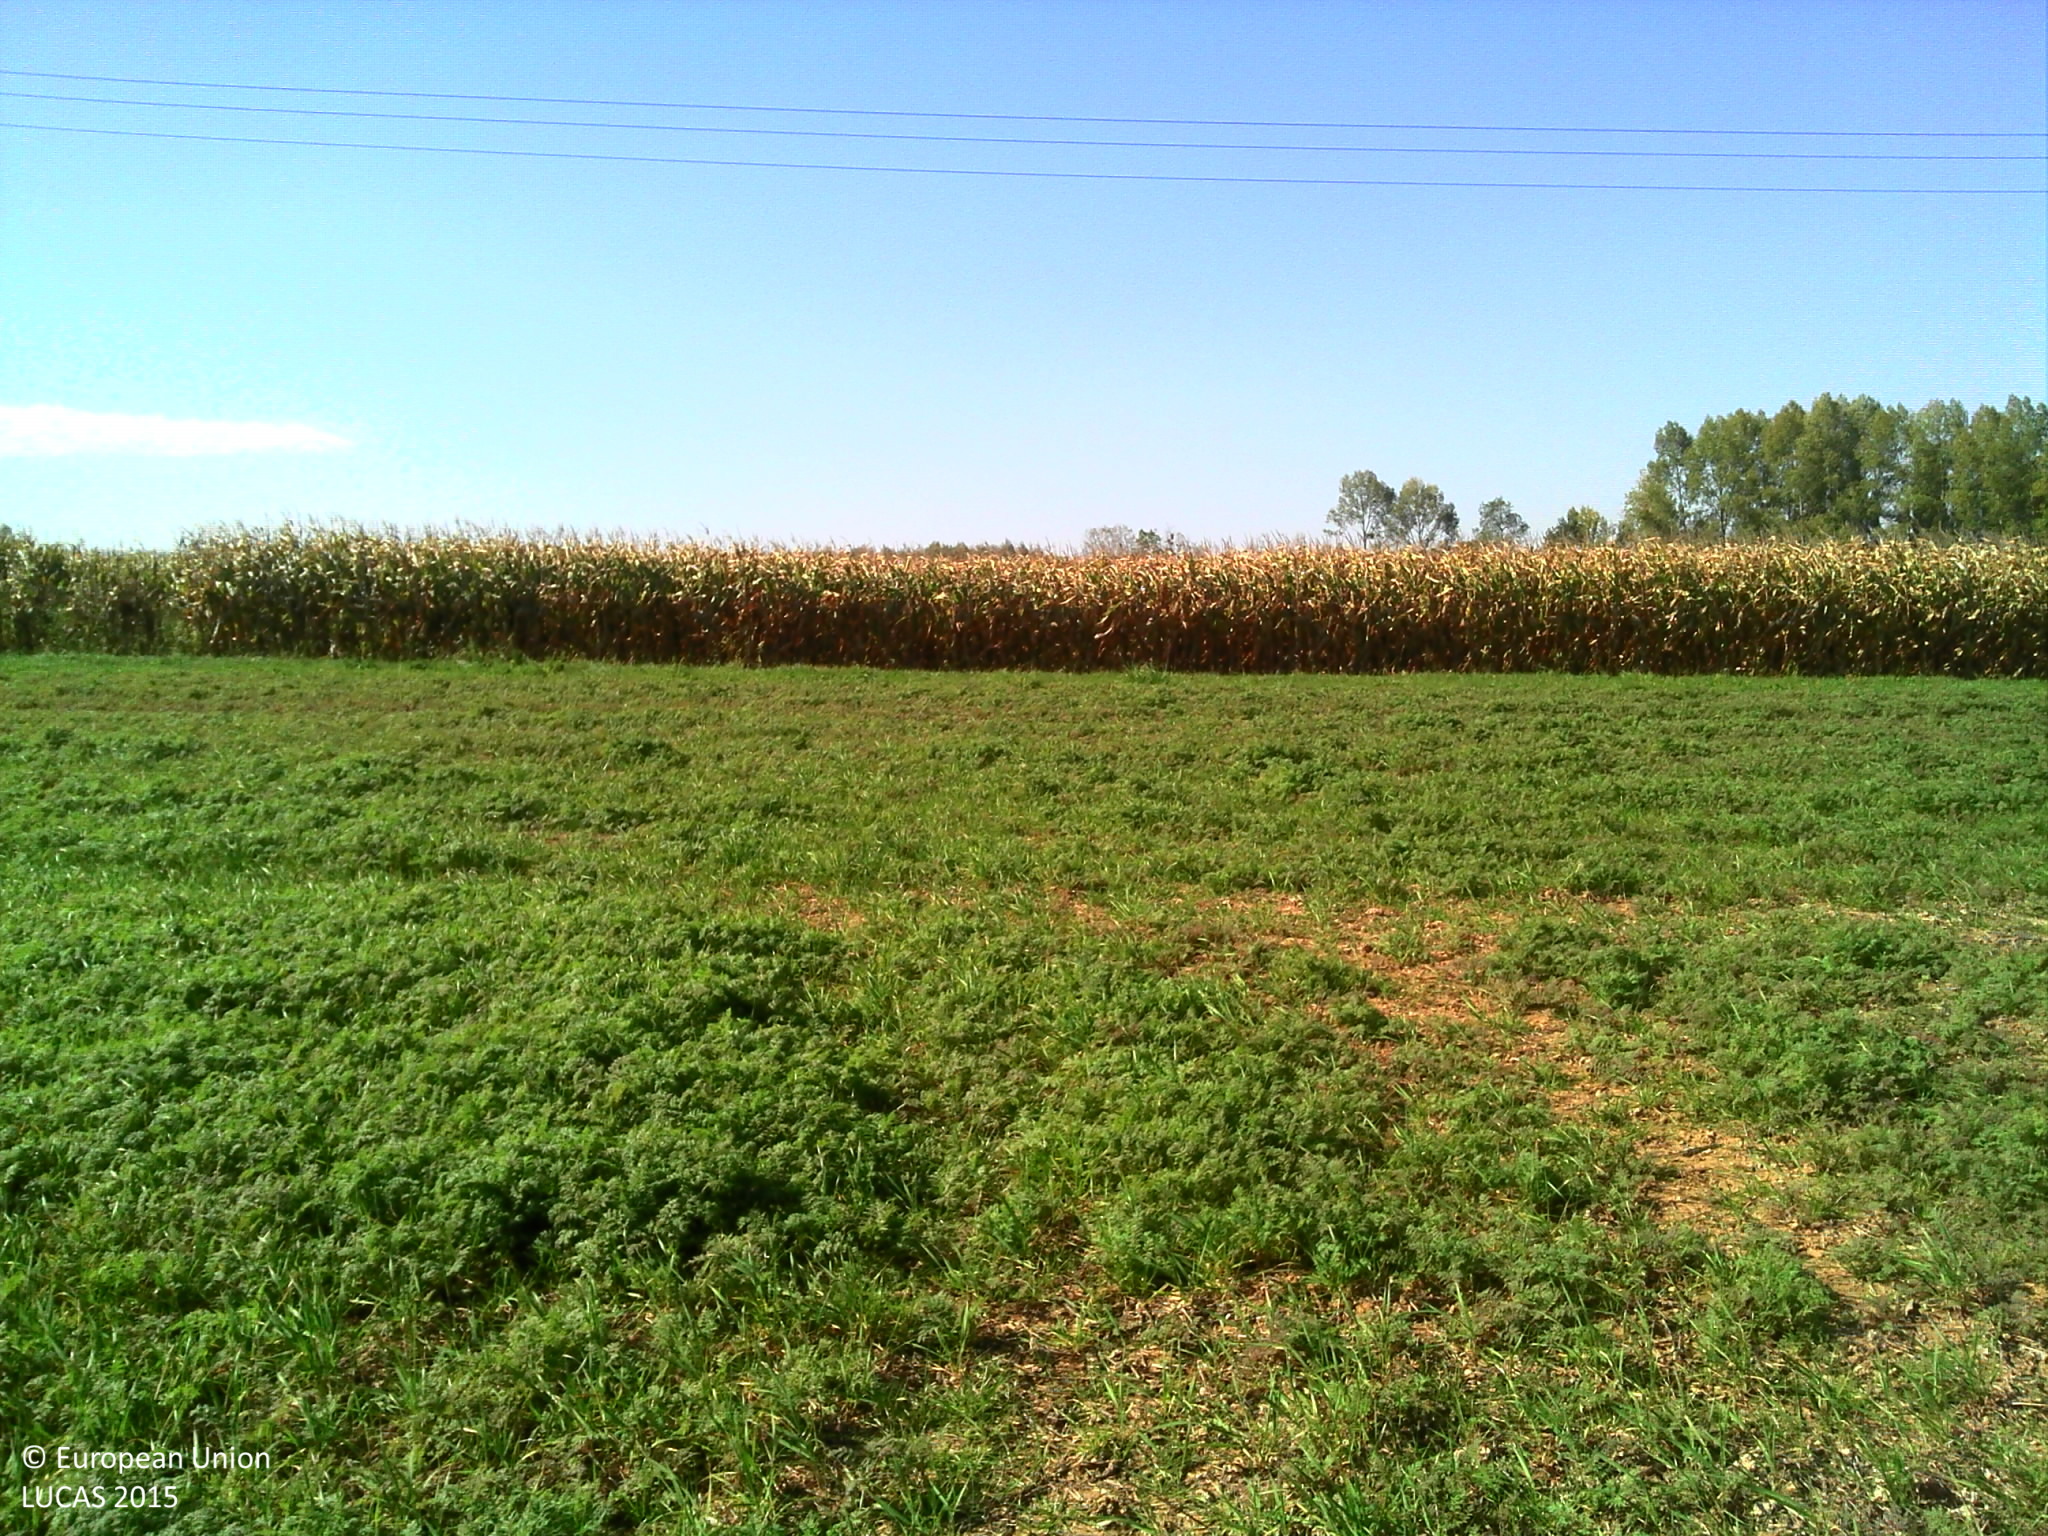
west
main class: Cropland
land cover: Other leguminous and mixtures for fodder
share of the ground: 25 - 50 %
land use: Agriculture (excluding fallow land and kitchen gardens)
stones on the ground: < 10 %
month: September
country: FR
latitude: 46.5318
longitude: -1.1287
